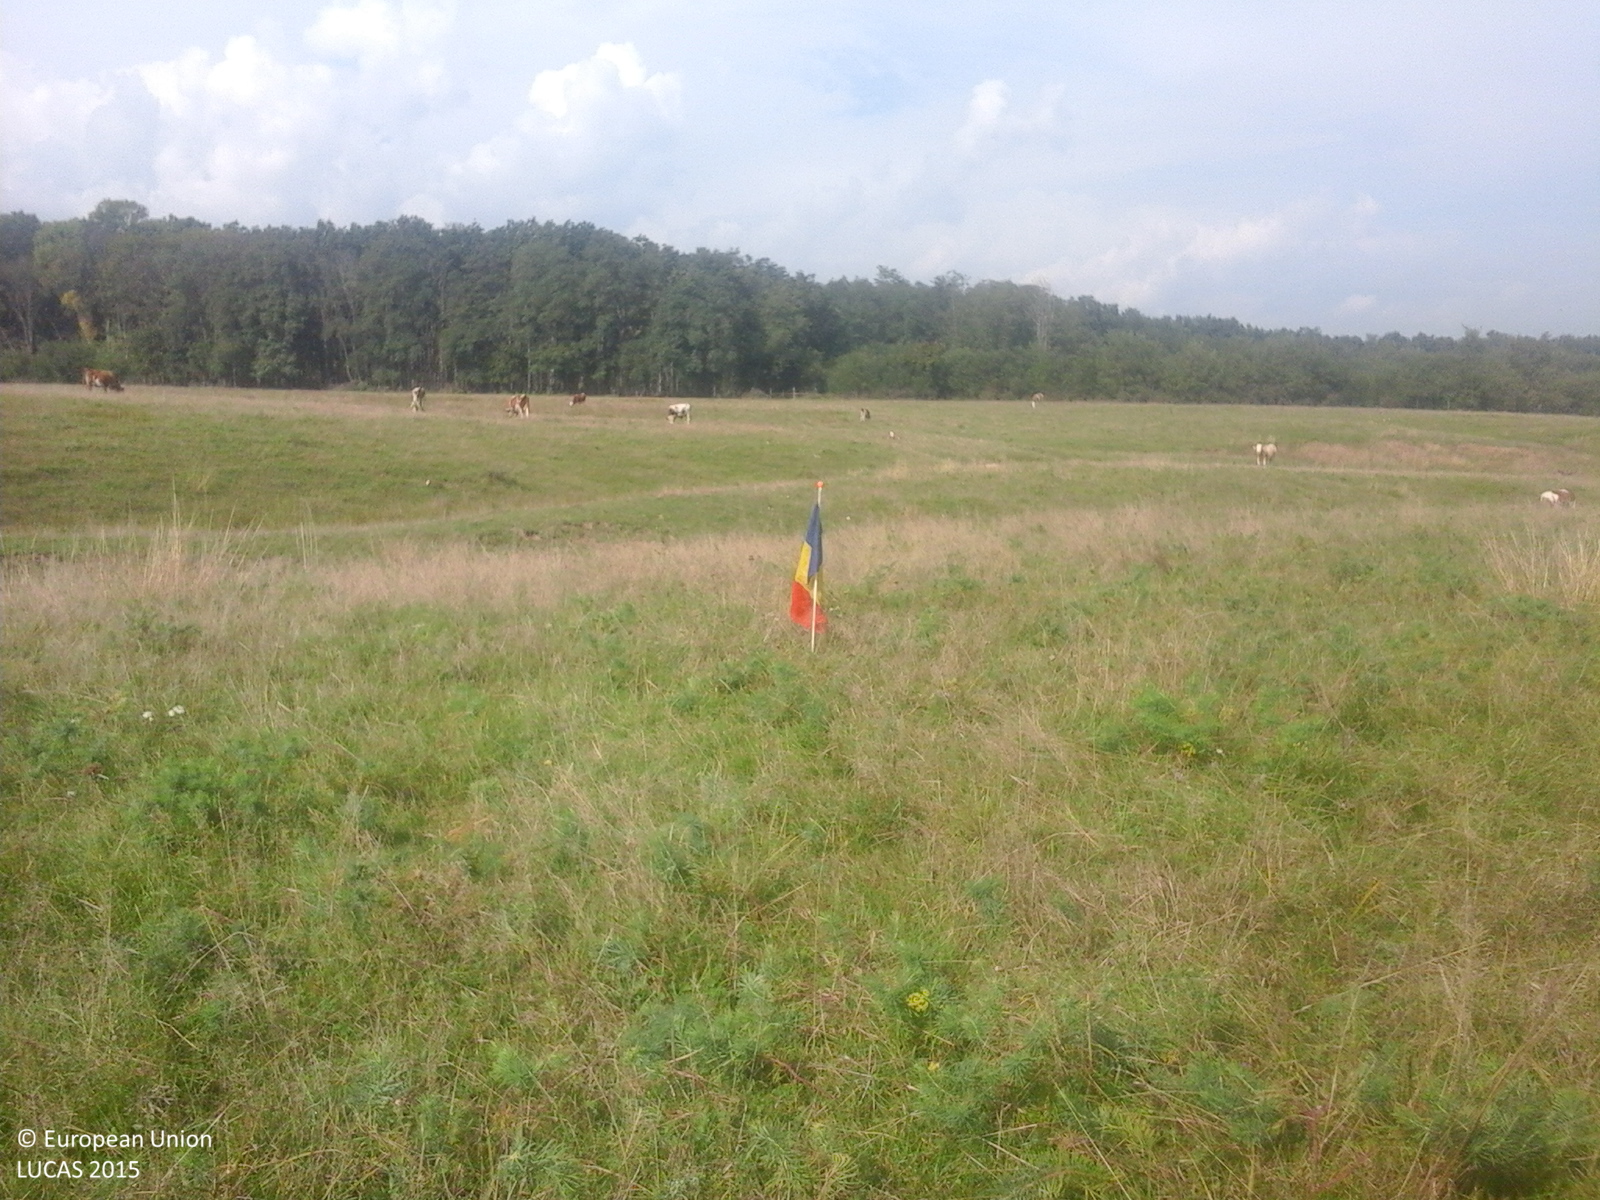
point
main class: Grassland
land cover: Grassland without tree/shrub cover
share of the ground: > 75 %
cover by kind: herbaceous plants 100 %
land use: Agriculture (excluding fallow land and kitchen gardens)
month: October
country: RO
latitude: 46.3091
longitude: 23.6646
